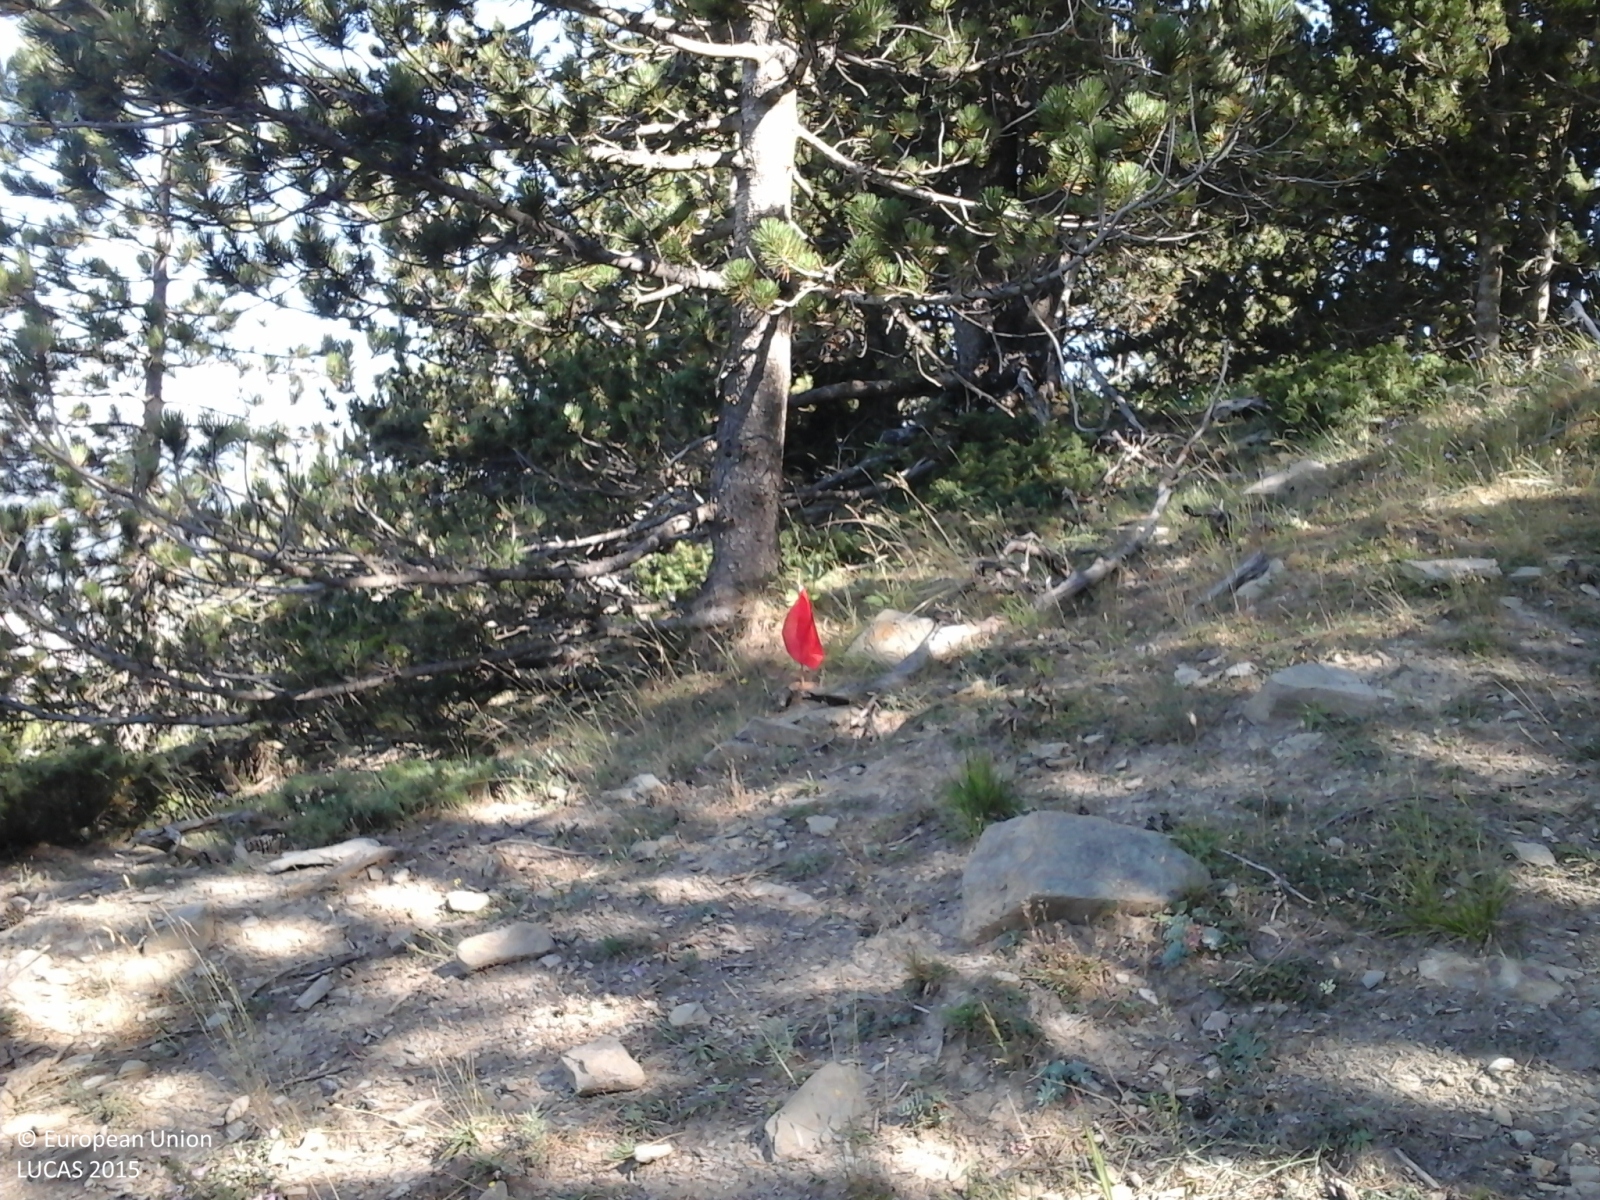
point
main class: Woodland
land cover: Pine dominated coniferous woodland
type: coniferous forest of the mediterranean region
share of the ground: 50 - 75 %
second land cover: Grassland without tree/shrub cover
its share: 10 - 25 %
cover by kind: coniferous forest trees 70 %, herbaceous plants 20 %, consolidated bare surface 10 %
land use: Forestry
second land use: Agriculture (excluding fallow land and kitchen gardens)
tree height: > 5 m
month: July
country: GR
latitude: 39.7493
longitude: 21.2205
